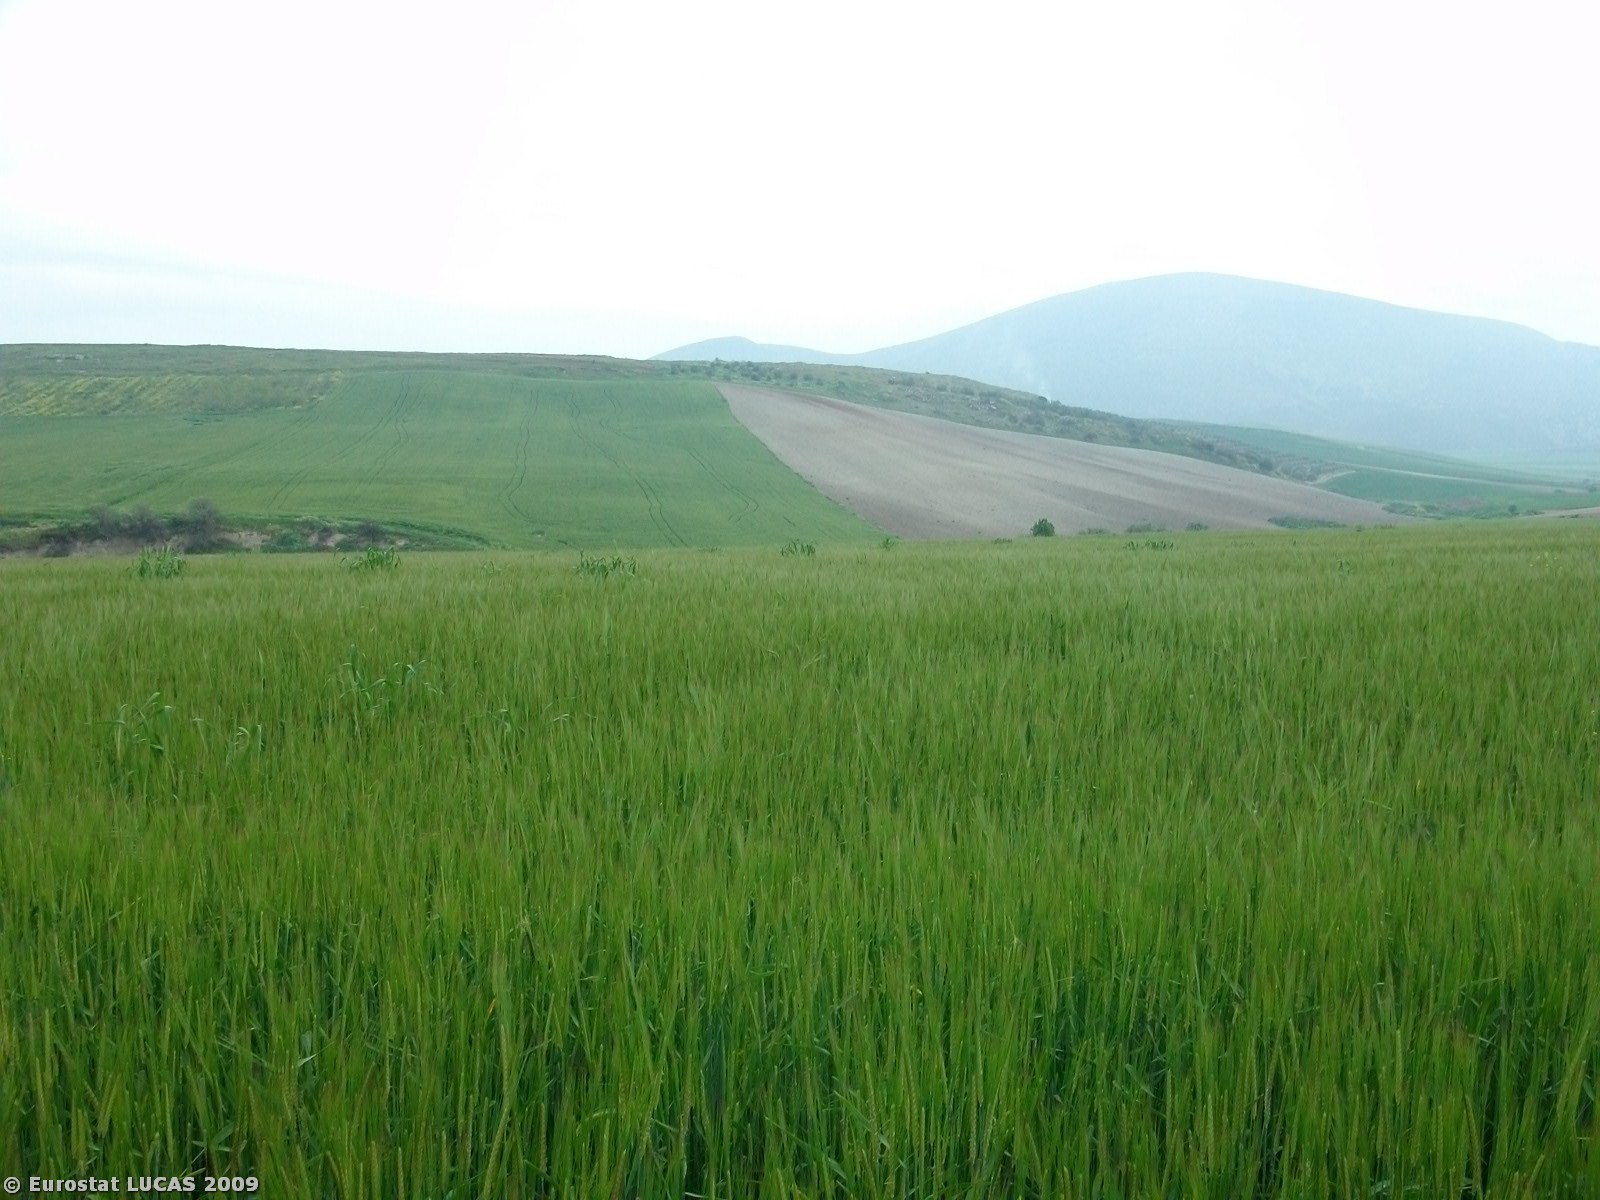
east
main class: Cropland
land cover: Common wheat
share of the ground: > 75 %
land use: Agriculture (excluding fallow land and kitchen gardens)
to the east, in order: Common wheat; Grassland without tree/shrub cover; Tracks; Grassland without tree/shrub cover; Durum wheat
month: April
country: GR
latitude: 39.4577
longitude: 22.5521
